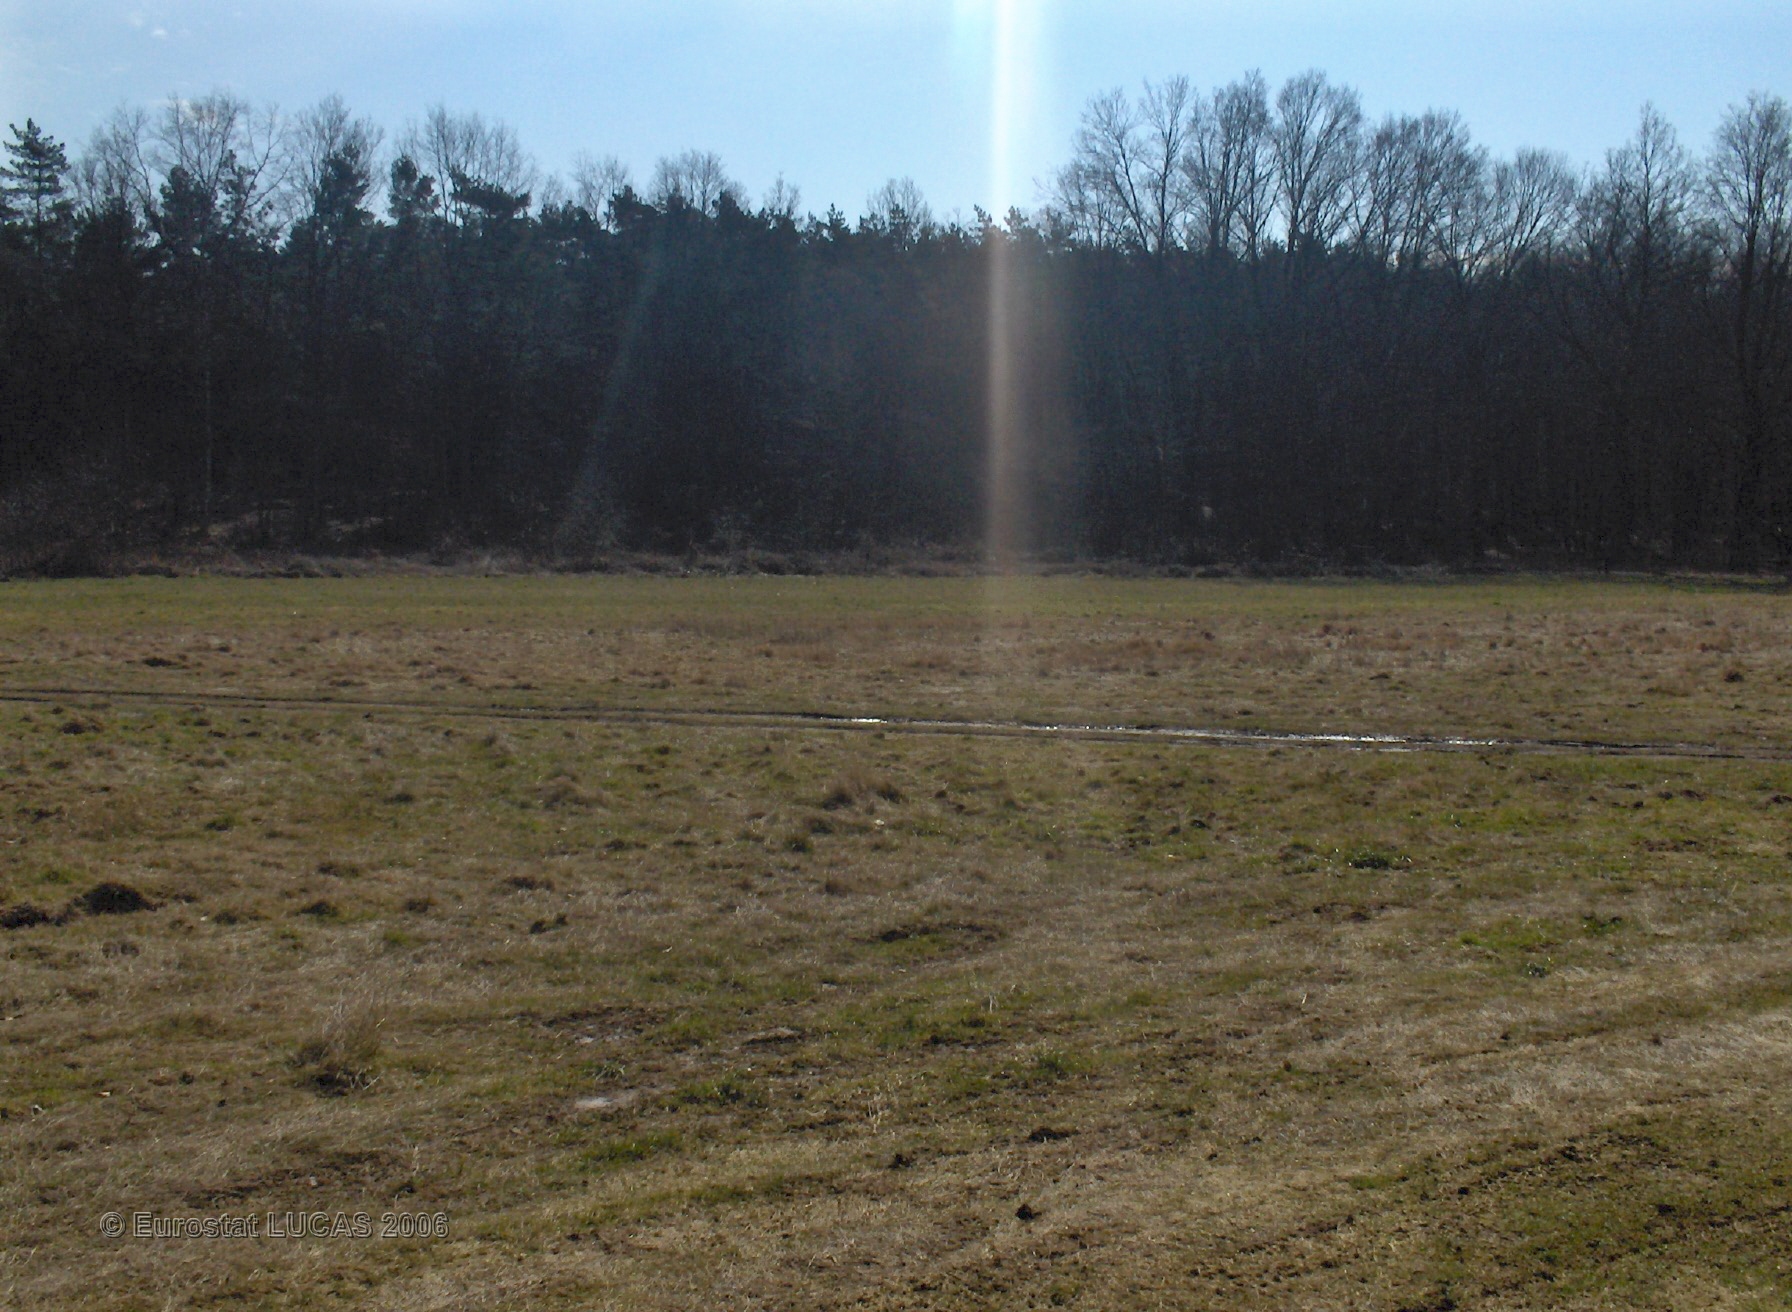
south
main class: Grassland
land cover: Grassland without tree/shrub cover
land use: Agriculture (excluding fallow land and kitchen gardens)
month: March
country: BE
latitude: 50.7011
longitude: 4.5164
